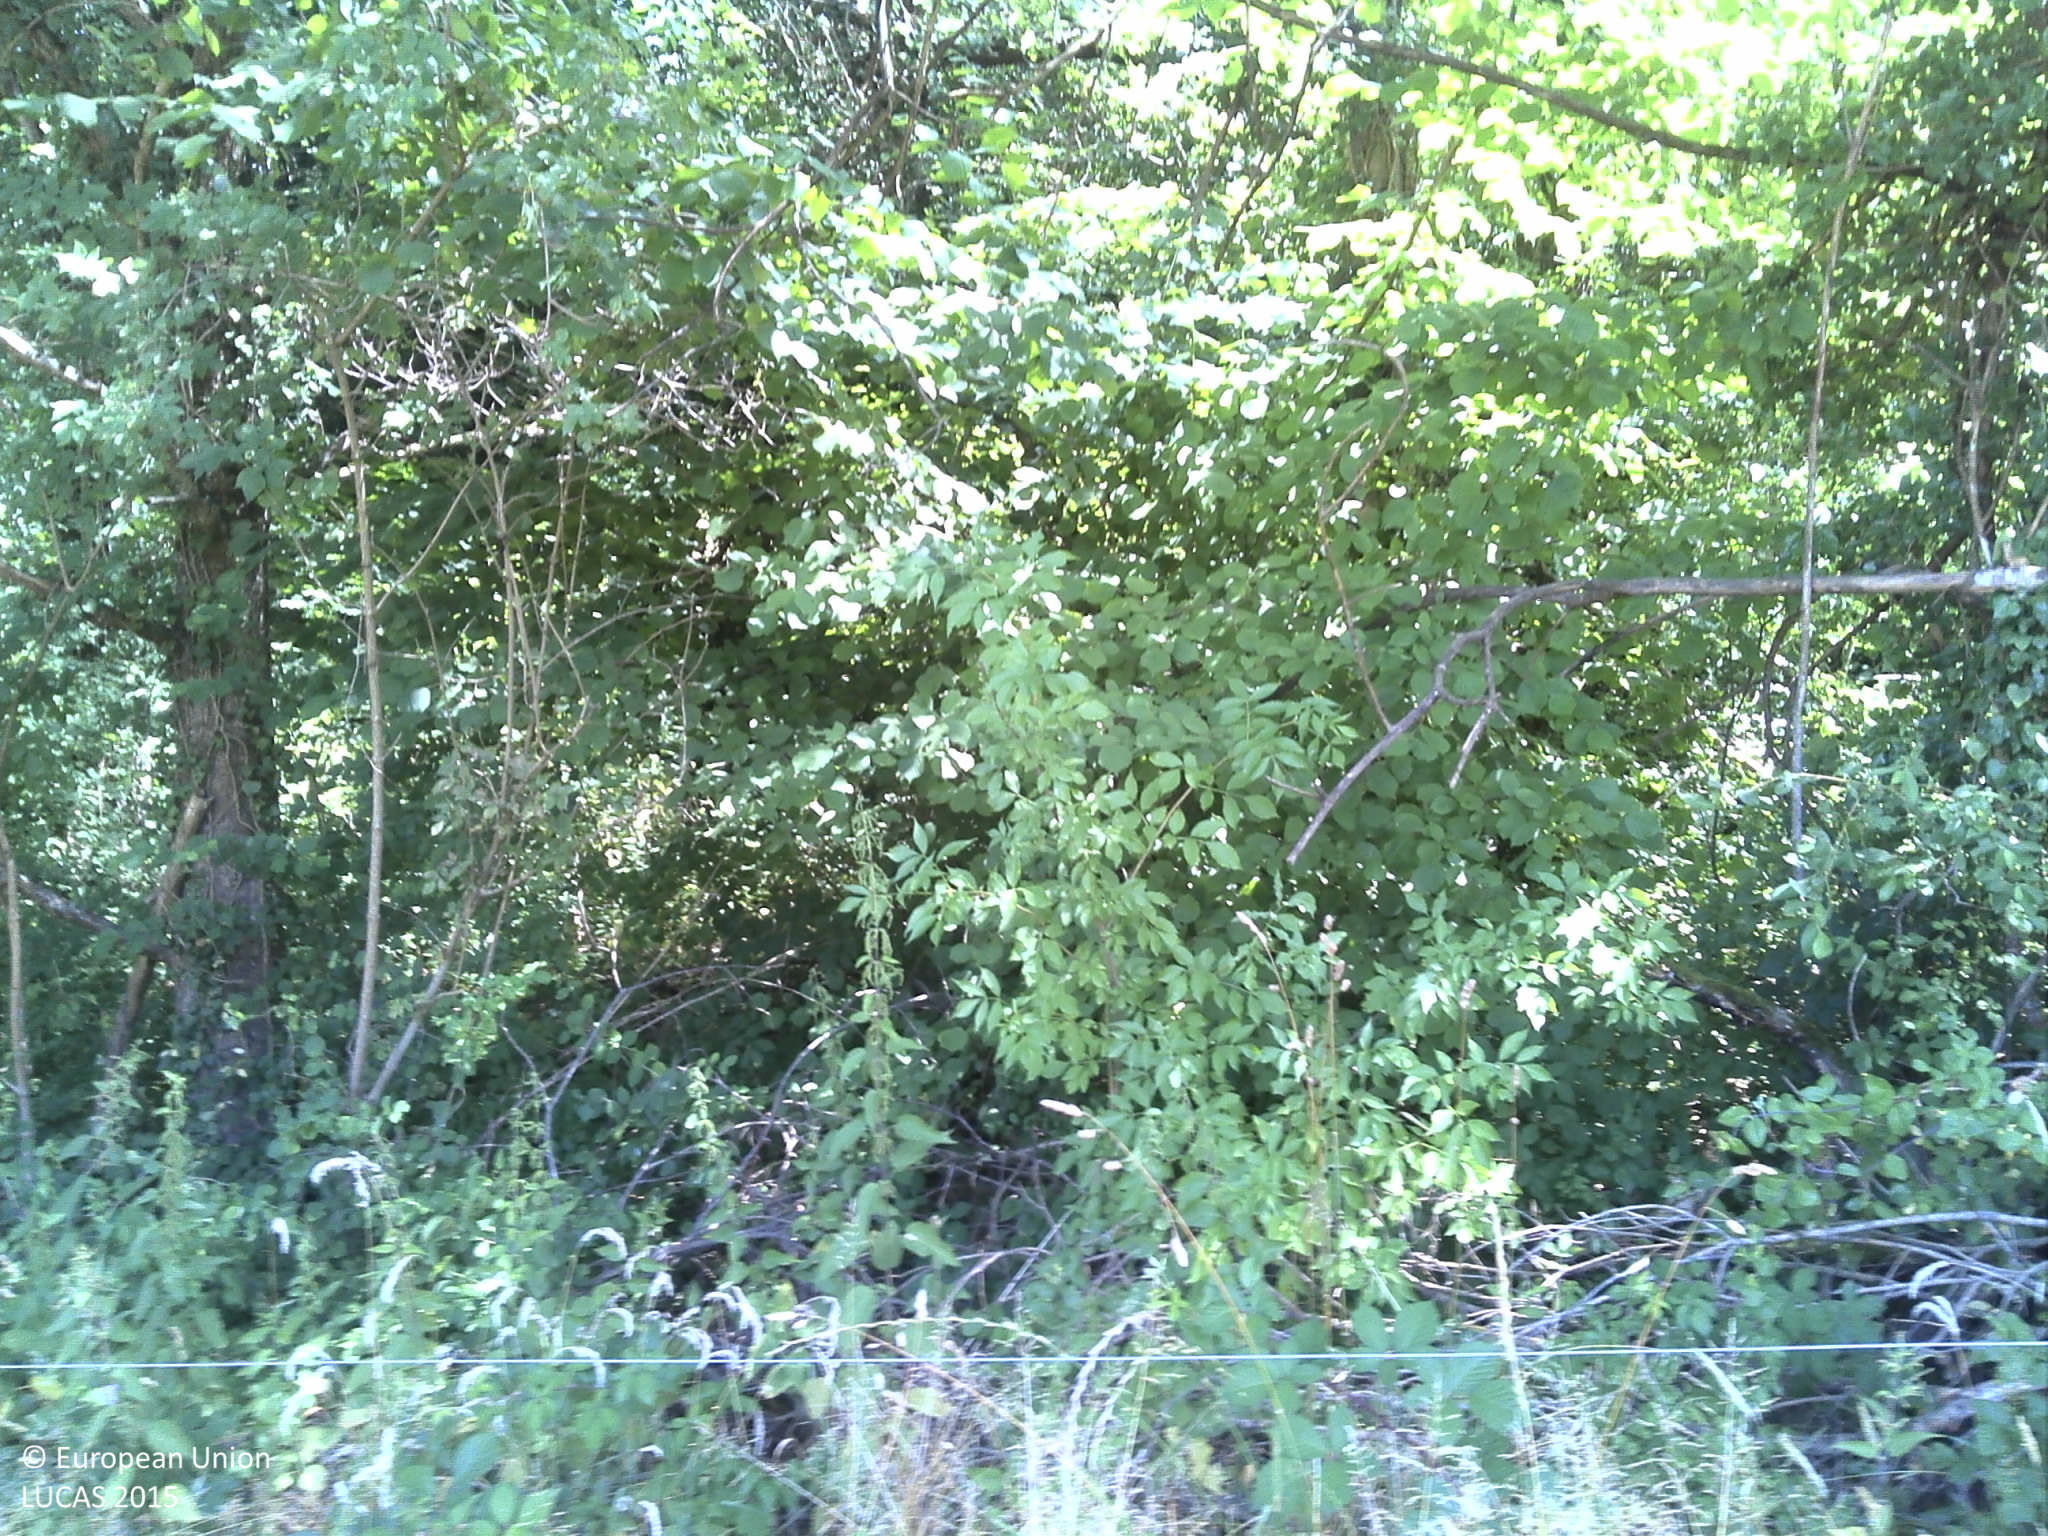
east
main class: Grassland
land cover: Grassland without tree/shrub cover
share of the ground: > 75 %
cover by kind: herbaceous plants 100 %
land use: Agriculture (excluding fallow land and kitchen gardens)
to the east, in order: Fences; Broadleaved woodland; Tracks; Lines of trees; Fences; Grassland without tree/shrub cover; Single bushes/trees; Inland fresh water bodies; Grassland without tree/shrub cover; Fences; Lines of trees; Grass margins; Tracks; Grass margins; Lines of trees; Fences; Grassland without tree/shrub cover; Fences; Common wheat
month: July
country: FR
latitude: 45.7142
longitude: 3.4107
